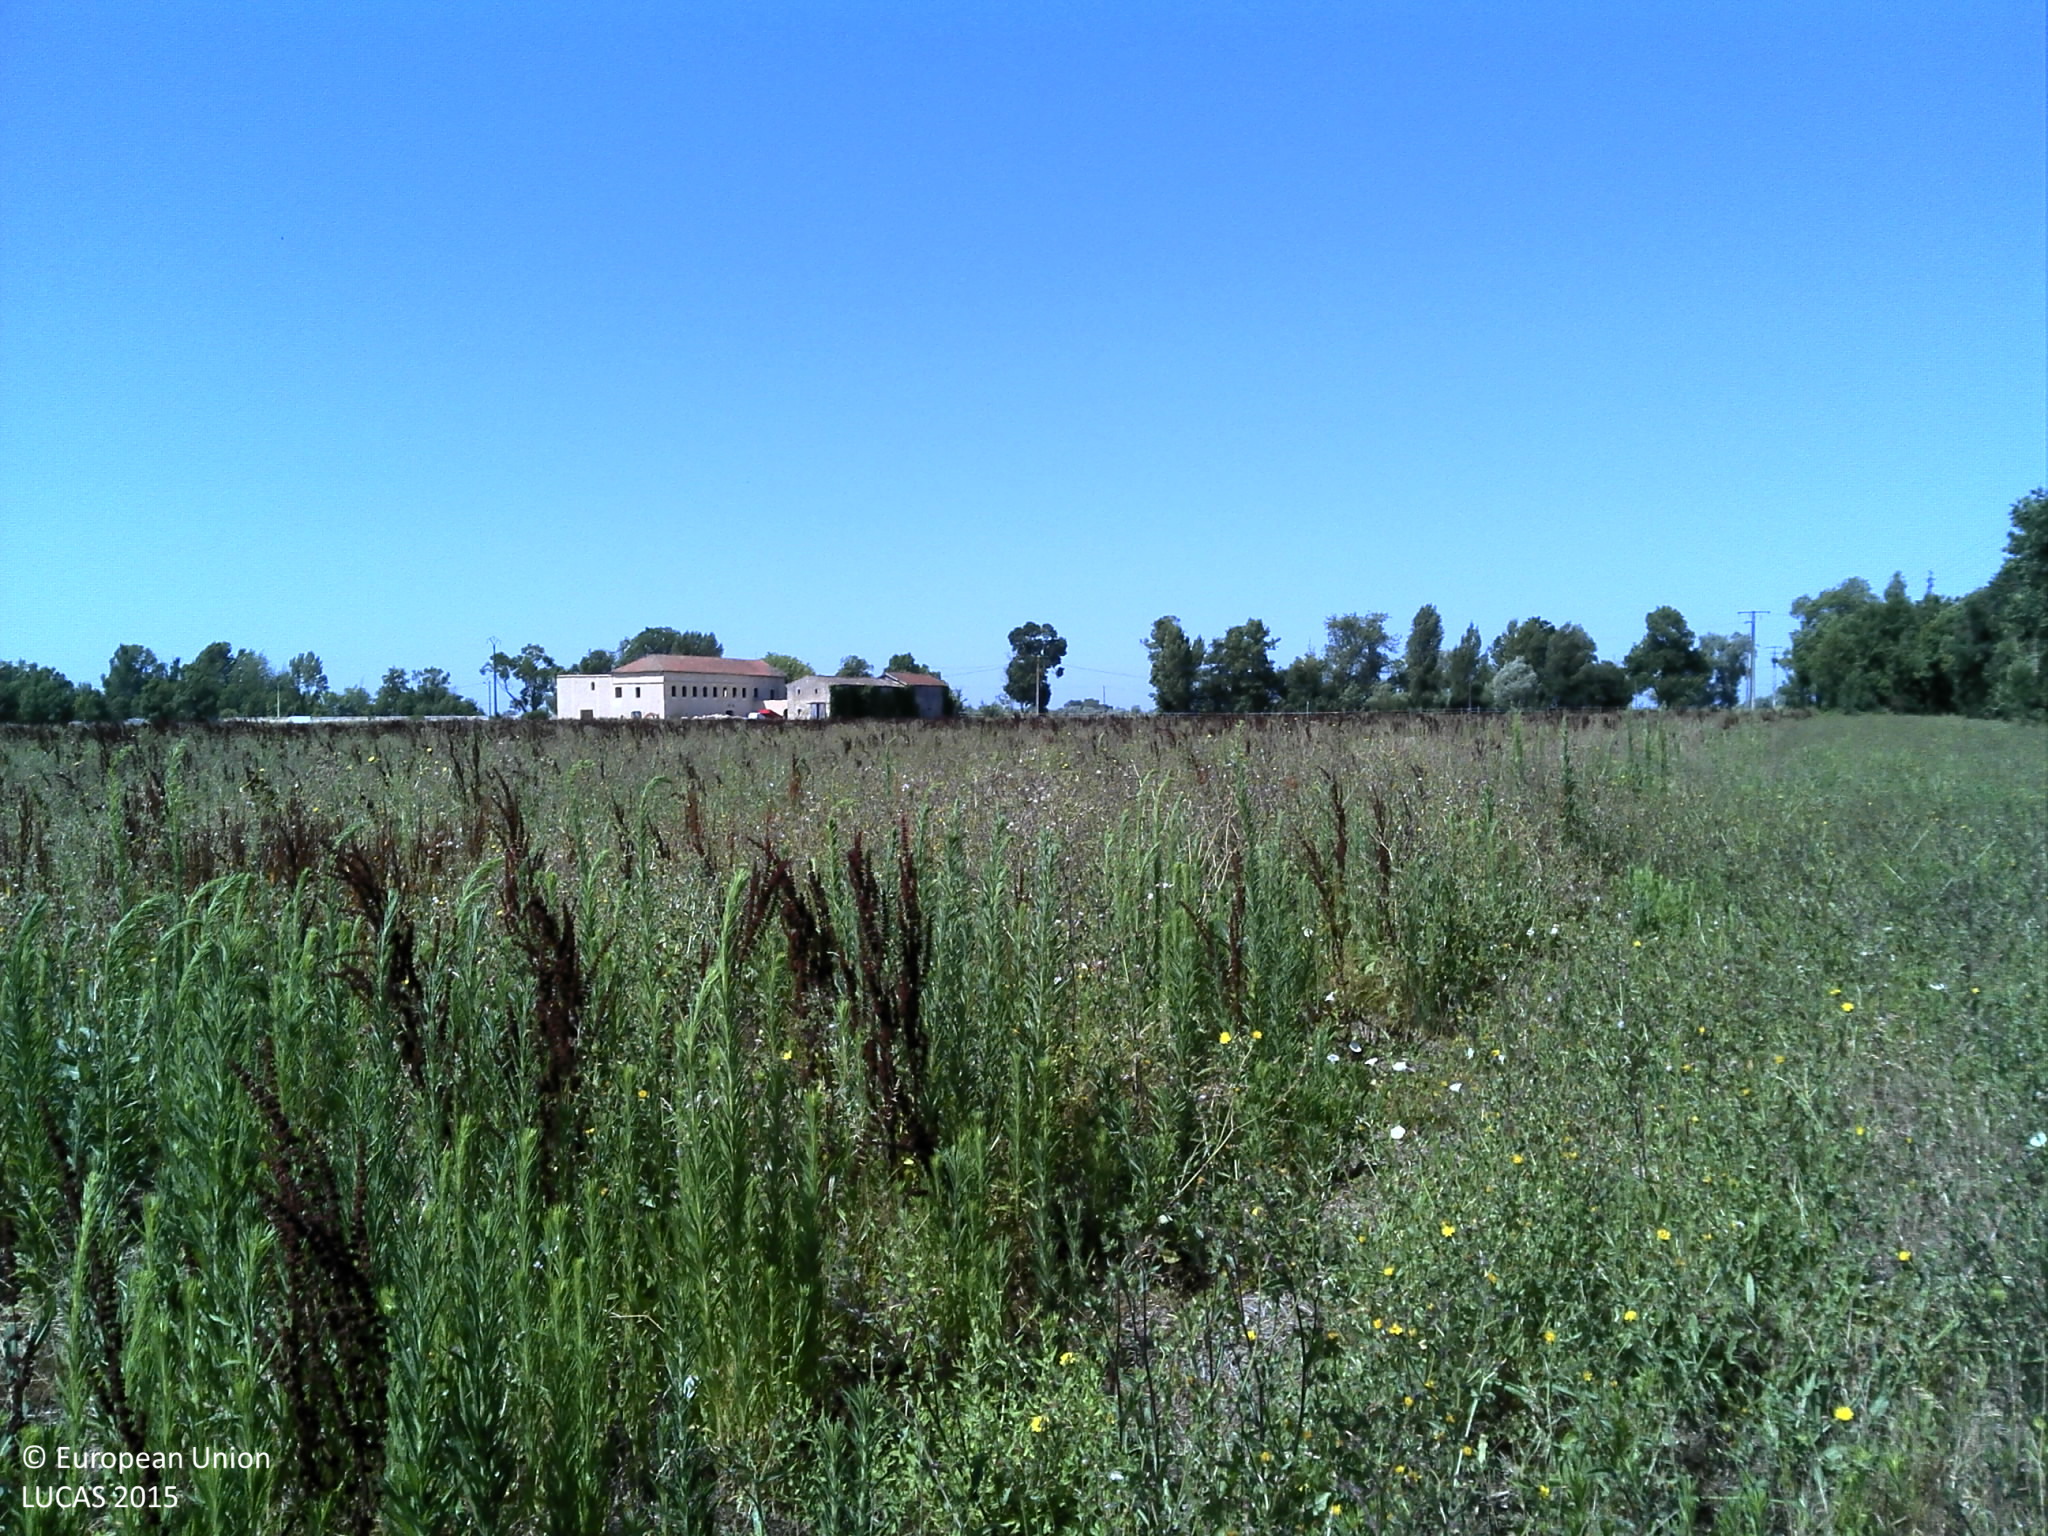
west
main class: Grassland
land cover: Spontaneously vegetated surfaces
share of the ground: > 75 %
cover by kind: herbaceous plants 100 %
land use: Fallow land
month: July
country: FR
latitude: 44.9762
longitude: -0.5311
